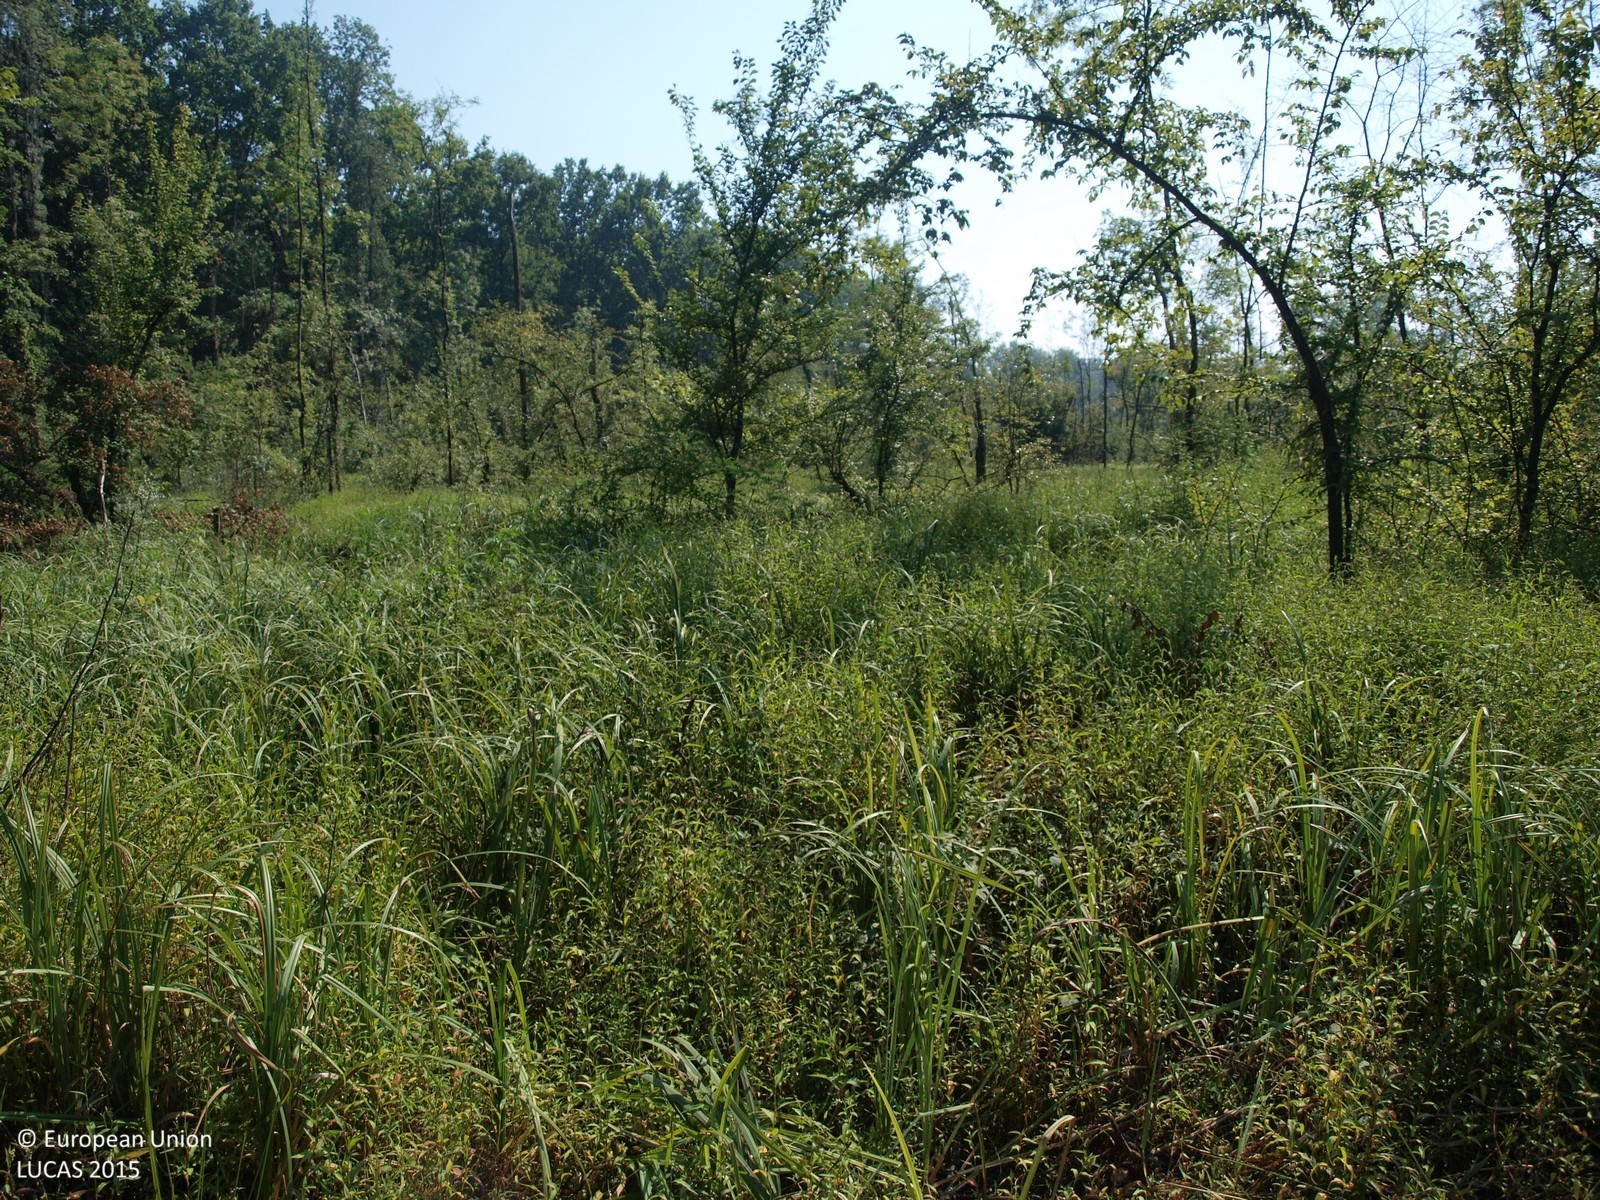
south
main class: Woodland
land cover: Broadleaved woodland
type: floodplain forest
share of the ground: > 75 %
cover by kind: broadleaved forest trees 100 %
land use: Forestry
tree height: > 5 m
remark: Clear cut
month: August
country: HR
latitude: 45.5950
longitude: 16.4721
